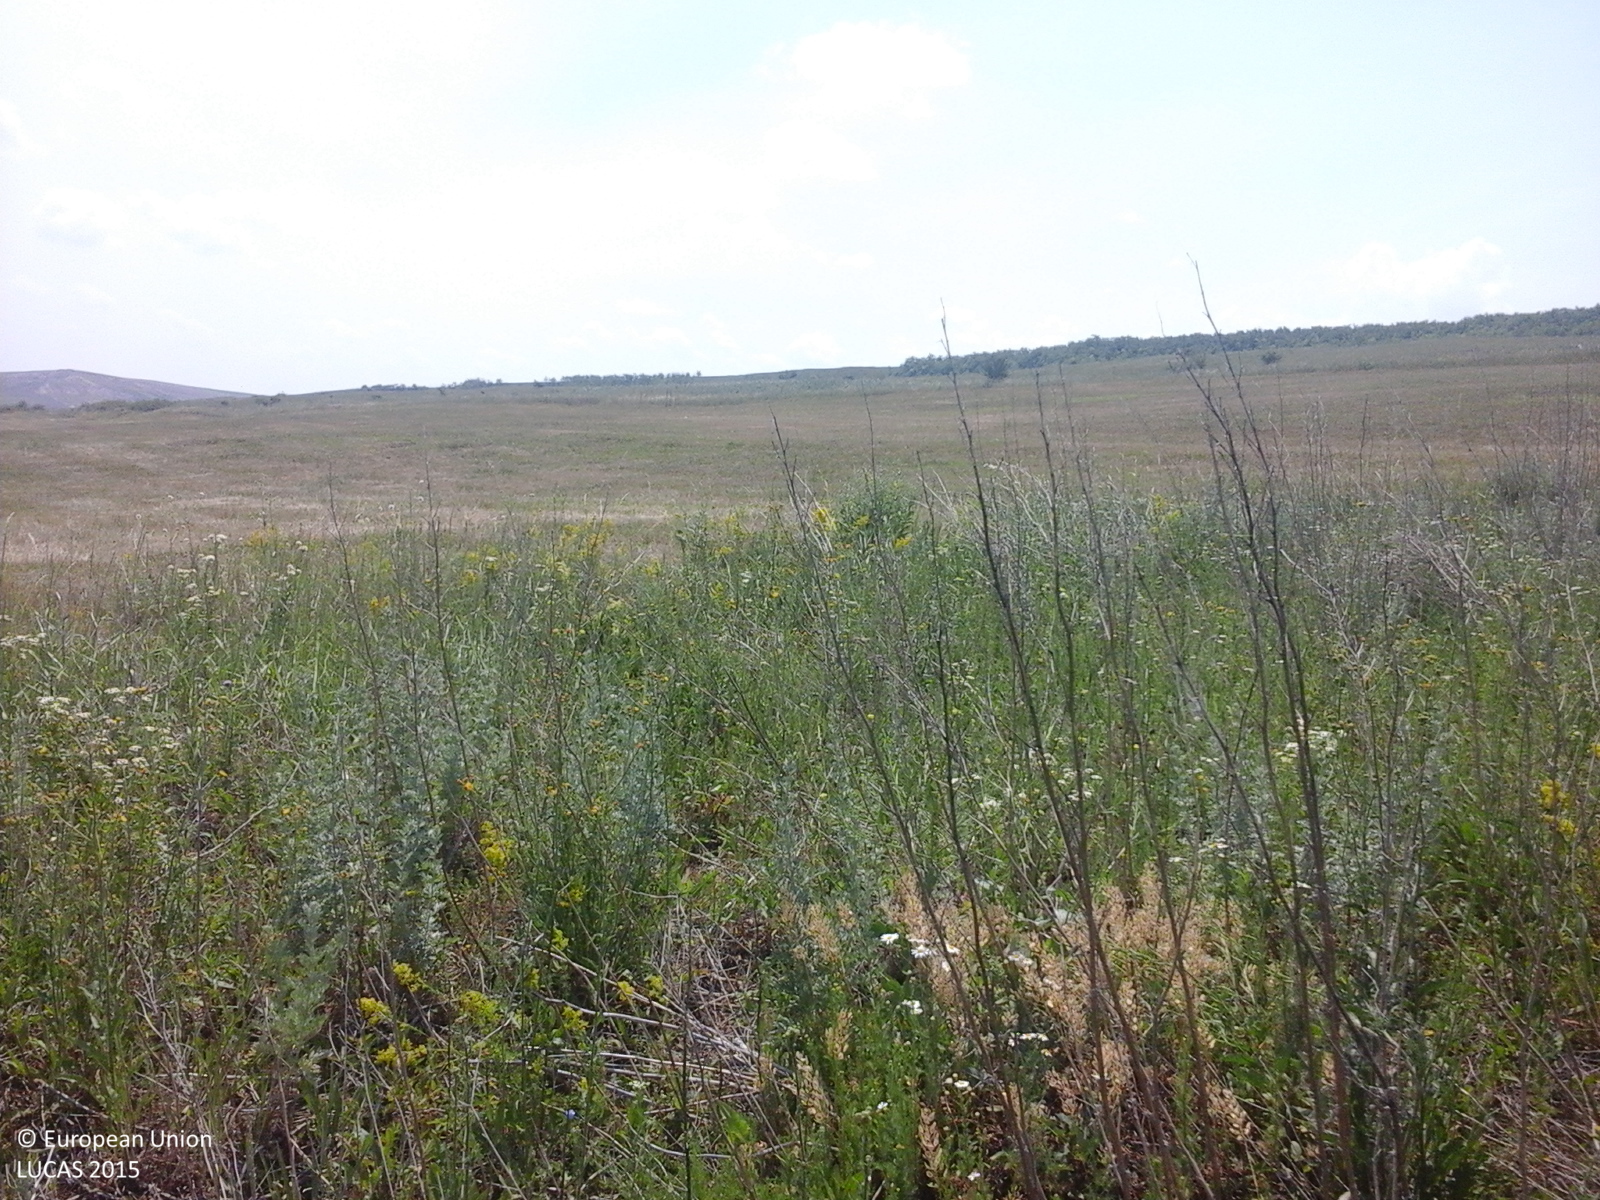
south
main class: Grassland
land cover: Spontaneously vegetated surfaces
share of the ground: > 75 %
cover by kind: herbaceous plants 100 %
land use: Agriculture (excluding fallow land and kitchen gardens)
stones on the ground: 10 - 25 %
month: June
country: RO
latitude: 47.4227
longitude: 27.0039
